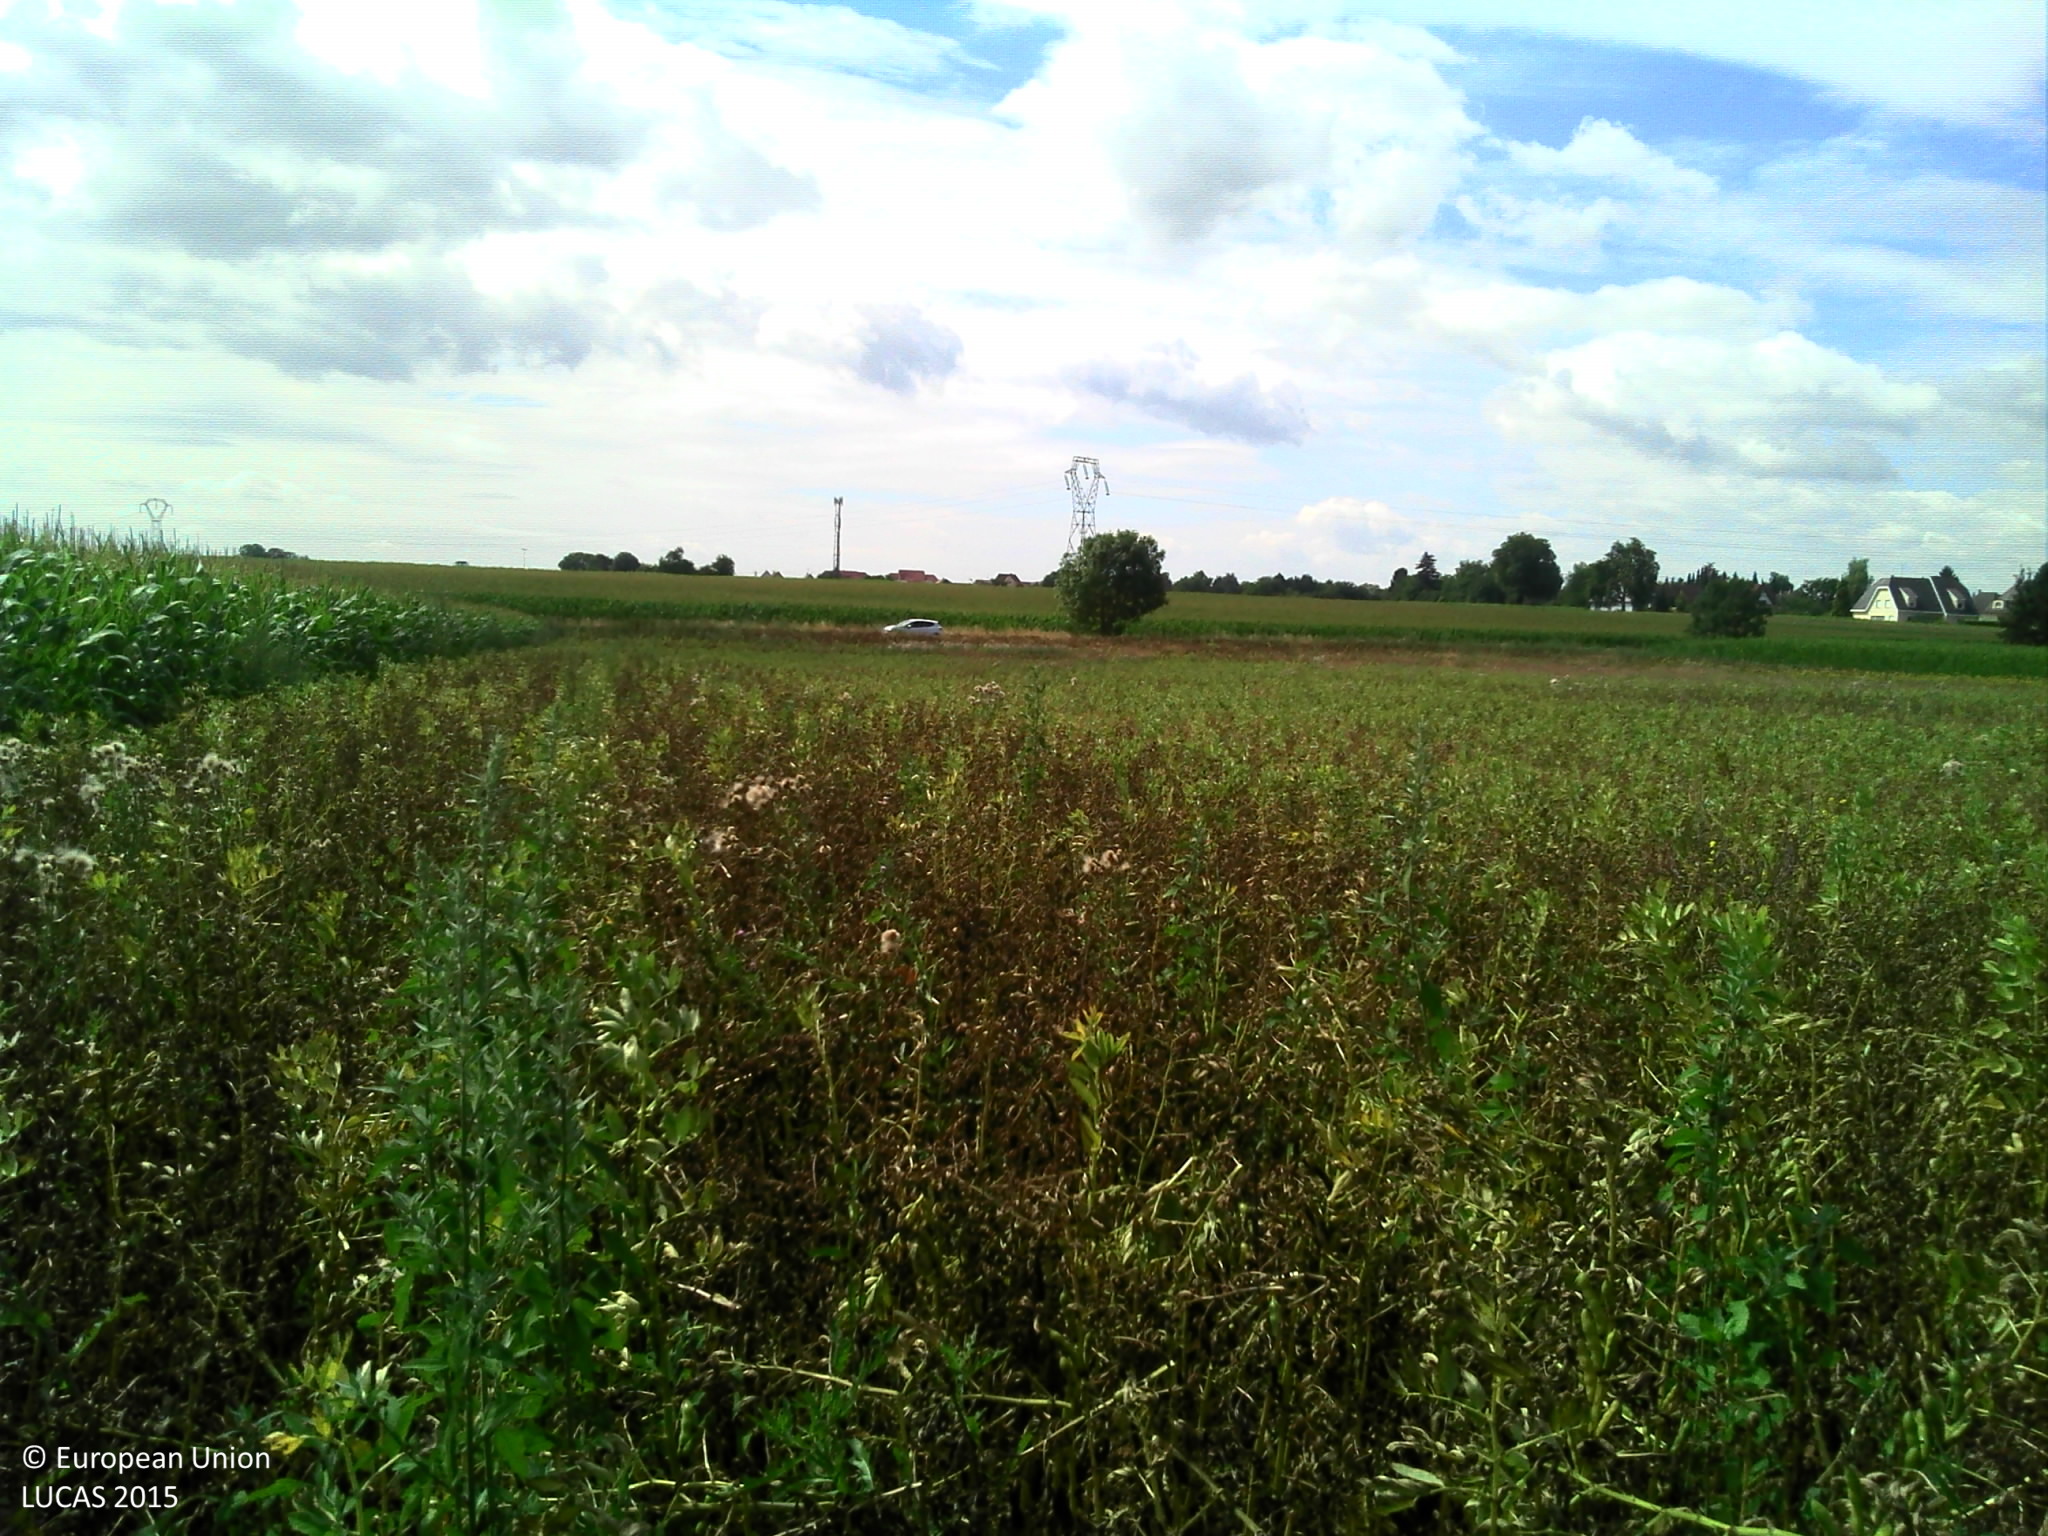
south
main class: Cropland
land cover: Soya
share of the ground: > 75 %
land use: Agriculture (excluding fallow land and kitchen gardens)
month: July
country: FR
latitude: 48.6115
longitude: 7.6001
